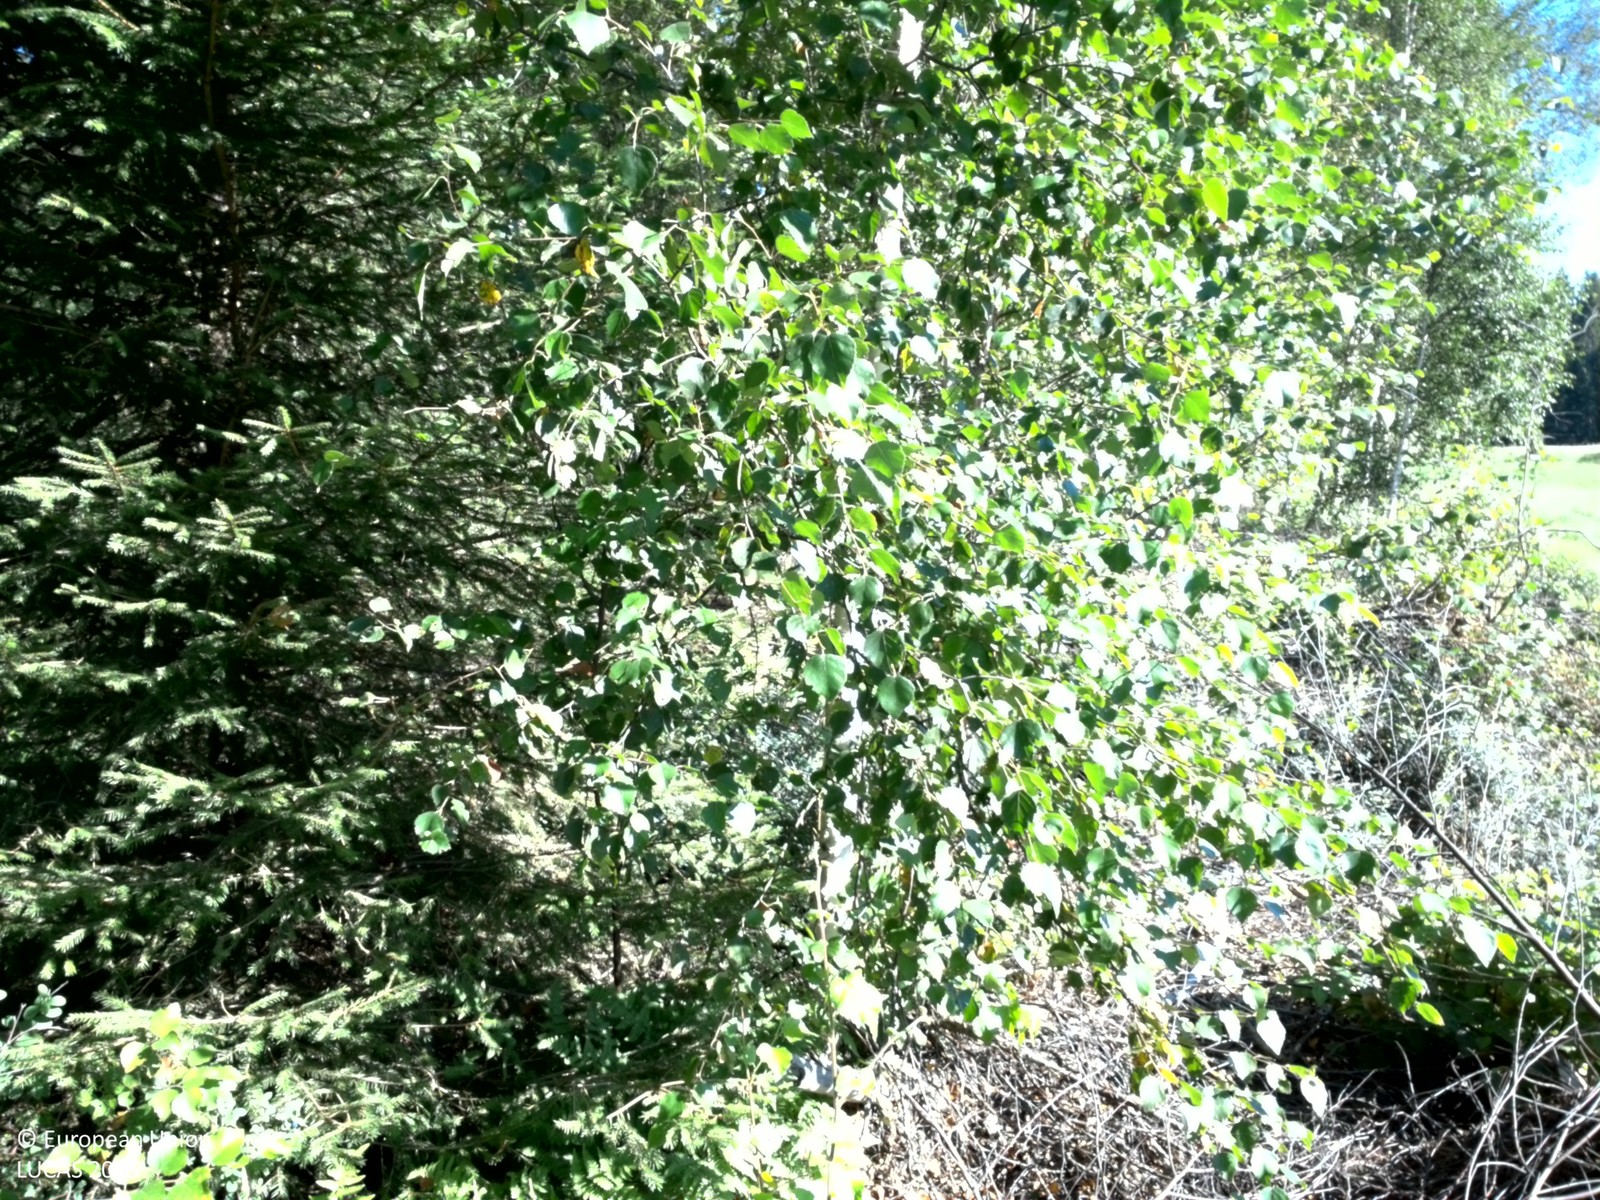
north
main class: Woodland
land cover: Broadleaved woodland
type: hemiboreal forest and nemoral coniferous forest and mixed broadleaved-coniferous forest
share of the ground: > 75 %
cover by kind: broadleaved forest trees 80 %, shrubs 15 %, coniferous forest trees 5 %
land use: Forestry
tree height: > 5 m
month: August
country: SE
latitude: 60.0621
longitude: 16.9793
